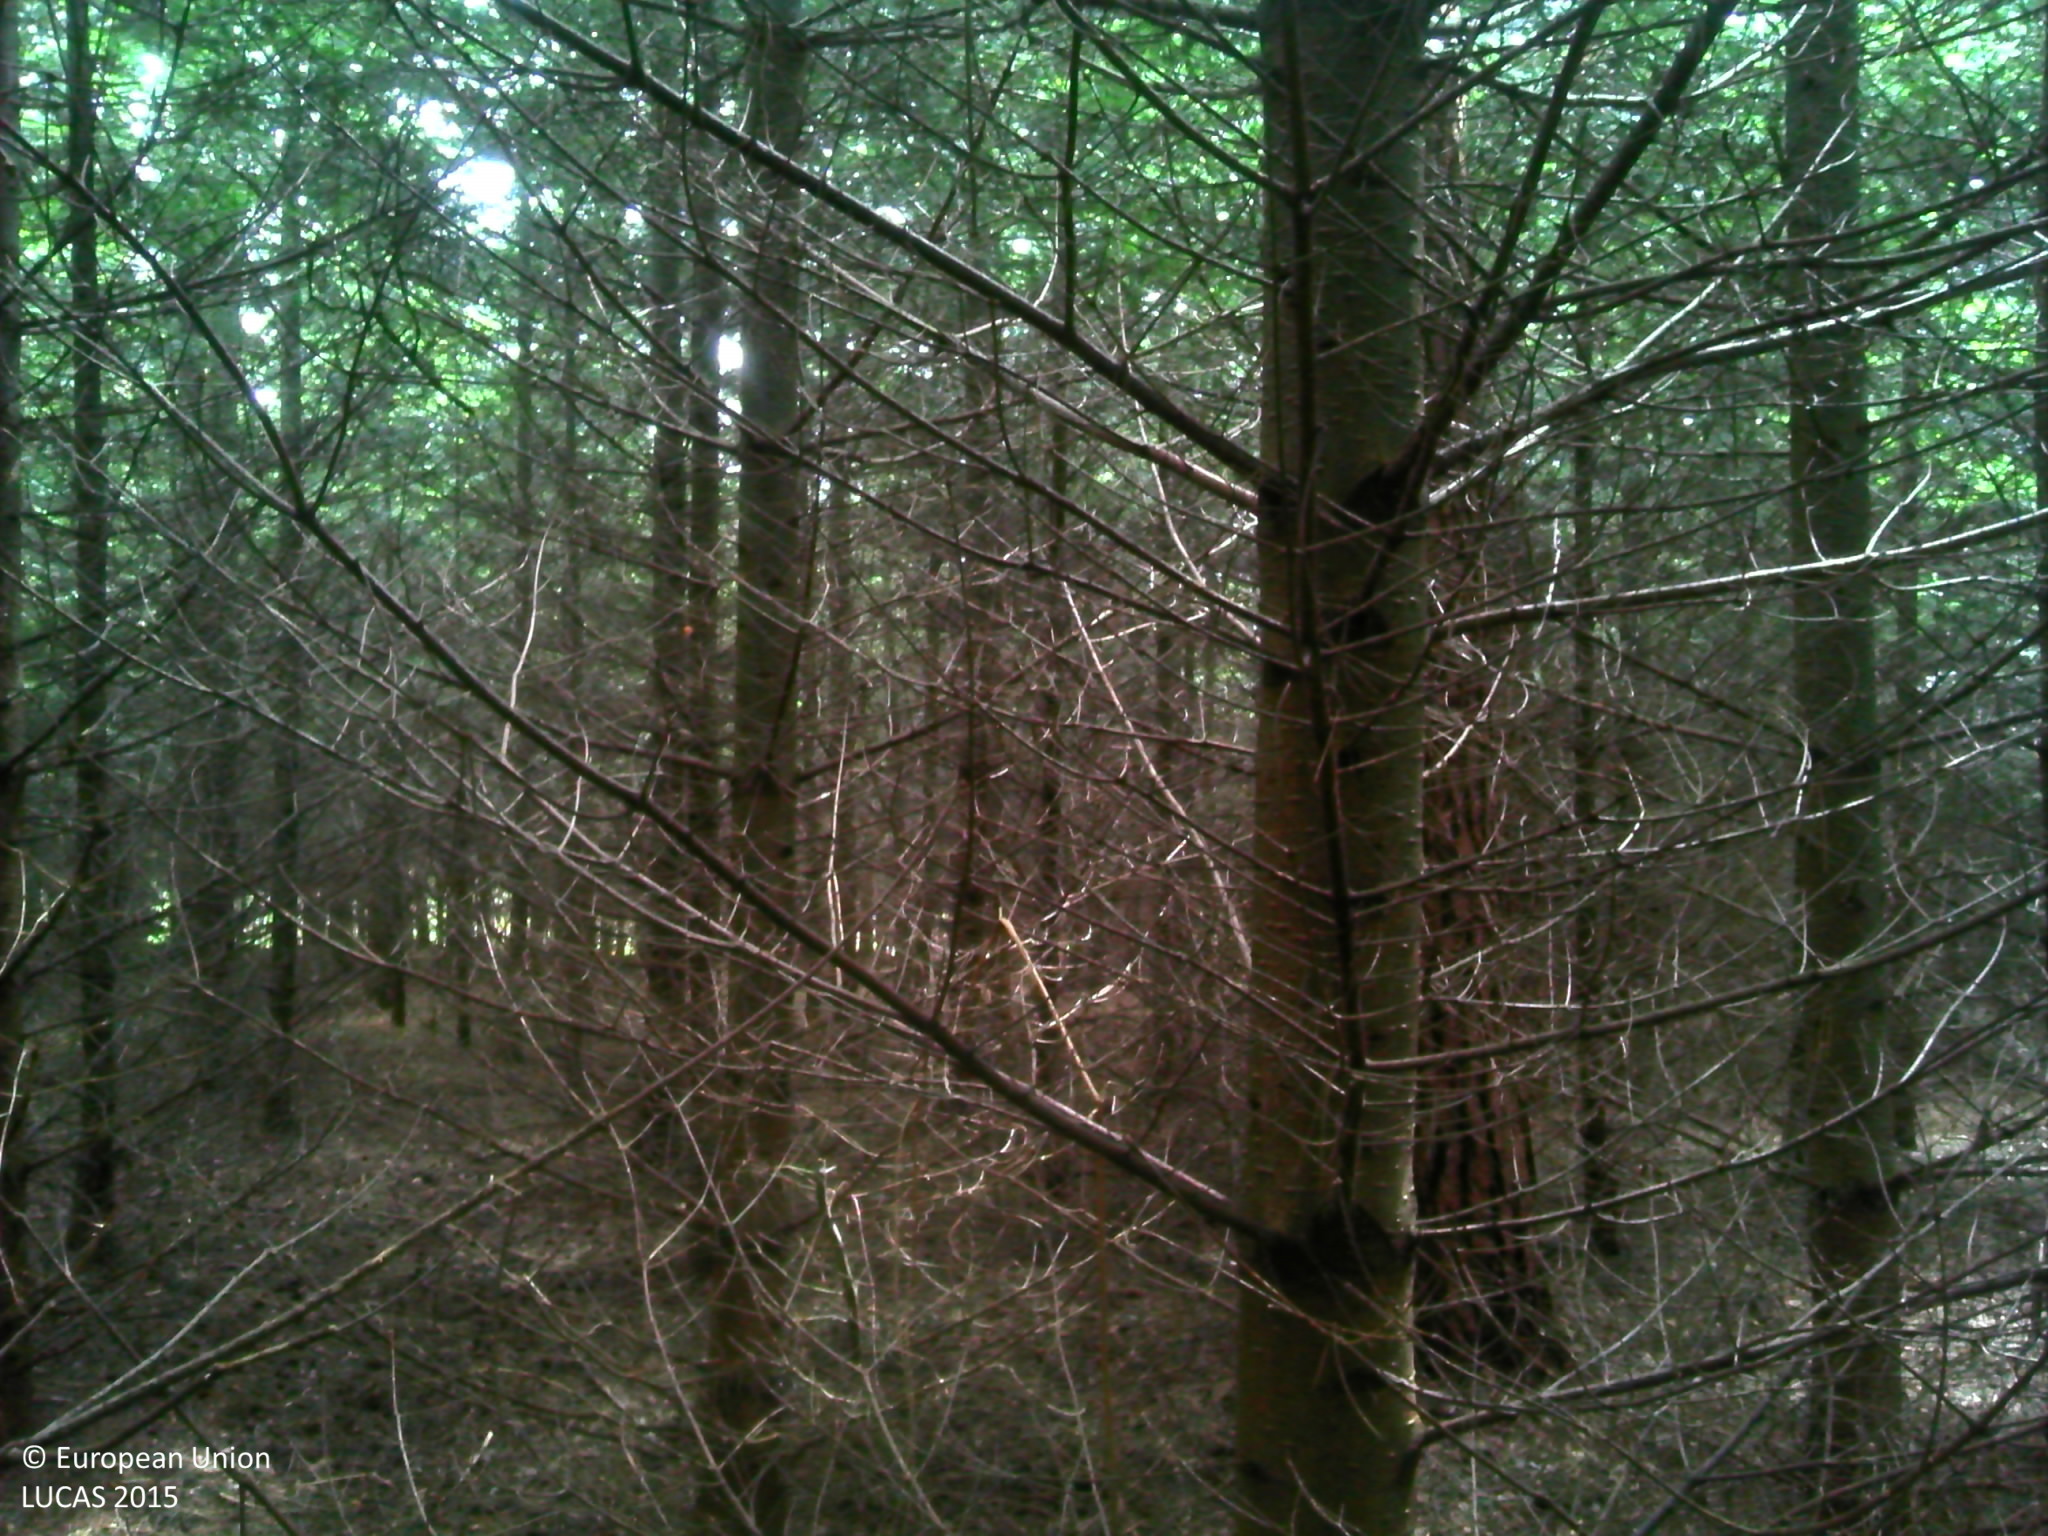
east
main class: Woodland
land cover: Other coniferous woodland
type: hemiboreal forest and nemoral coniferous forest and mixed broadleaved-coniferous forest
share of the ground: > 75 %
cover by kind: coniferous forest trees 95 %, broadleaved forest trees 5 %
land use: Forestry
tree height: > 5 m
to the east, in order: Other coniferous woodland; Broadleaved woodland; Rivers and streams; Spontaneously vegetated surfaces; Tracks; Grassland without tree/shrub cover; Shrubland without tree cover
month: June
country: BE
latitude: 49.9804
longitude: 4.9070
